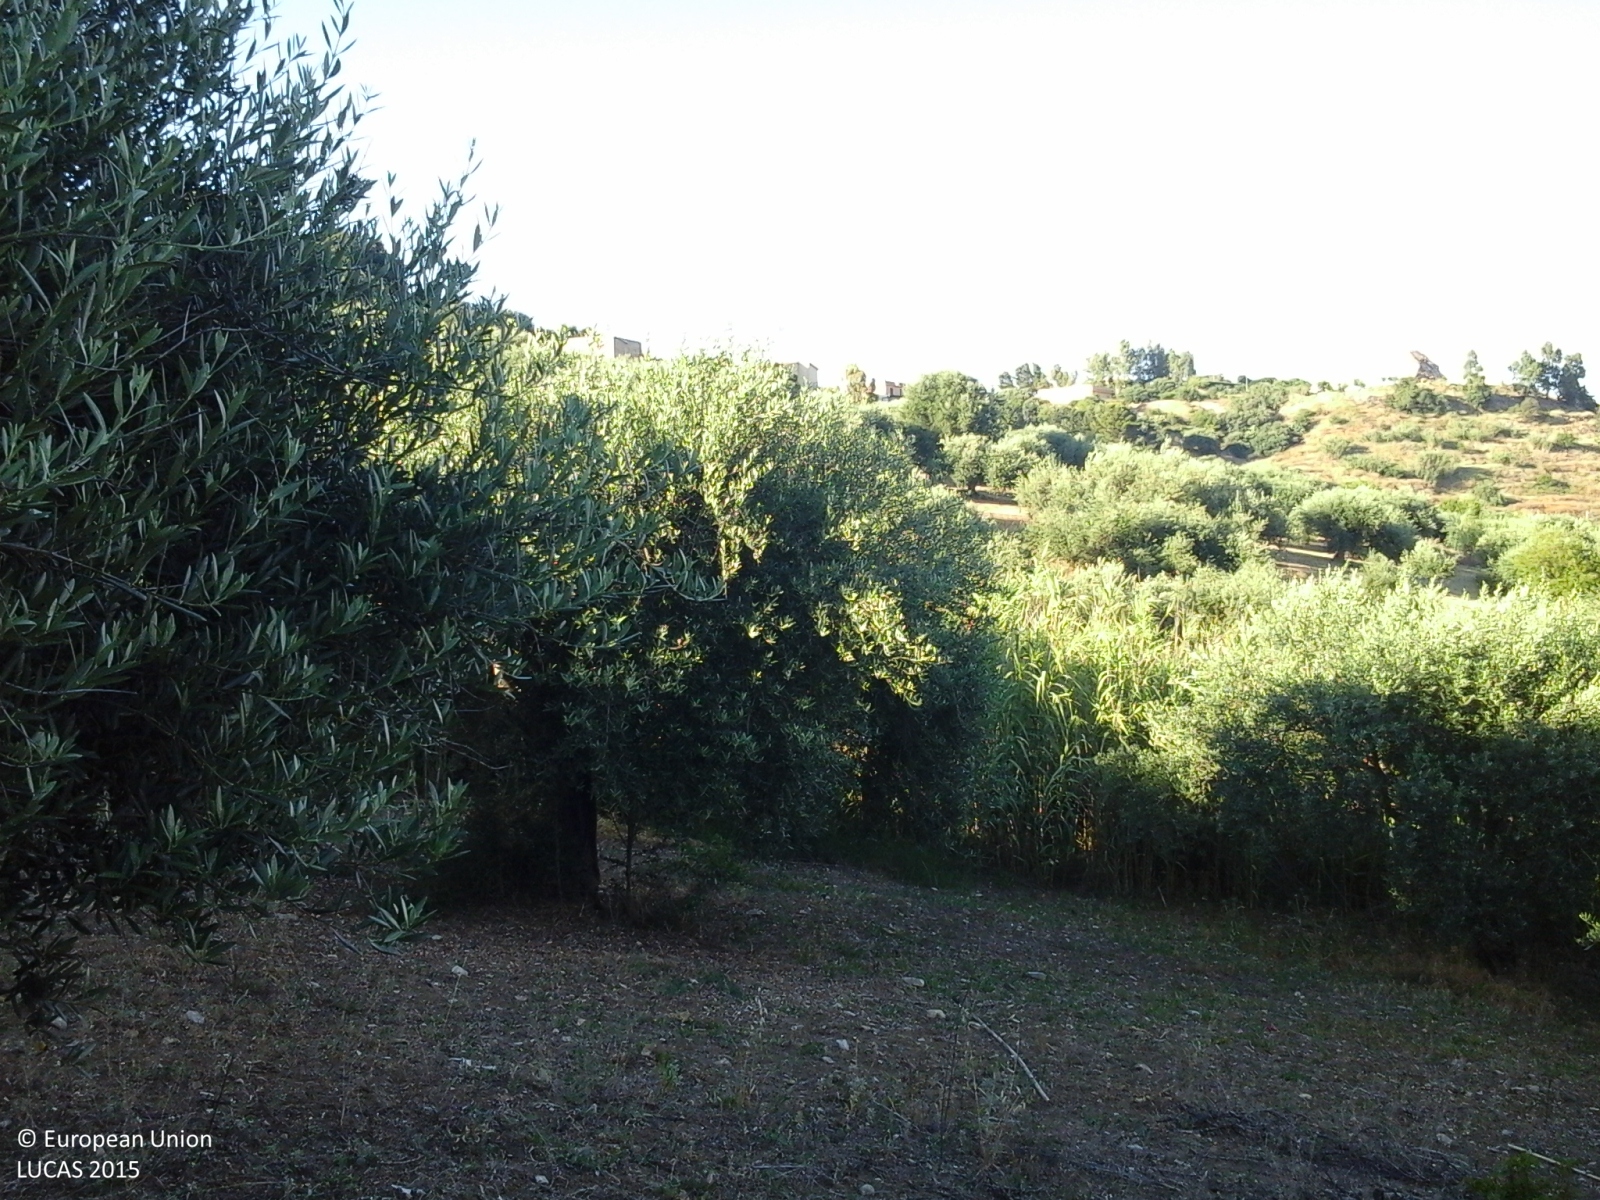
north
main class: Cropland
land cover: Olive groves
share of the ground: 50 - 75 %
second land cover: Spontaneously vegetated surfaces
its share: > 75 %
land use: Agriculture (excluding fallow land and kitchen gardens)
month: June
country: IT
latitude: 38.0276
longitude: 13.5182
